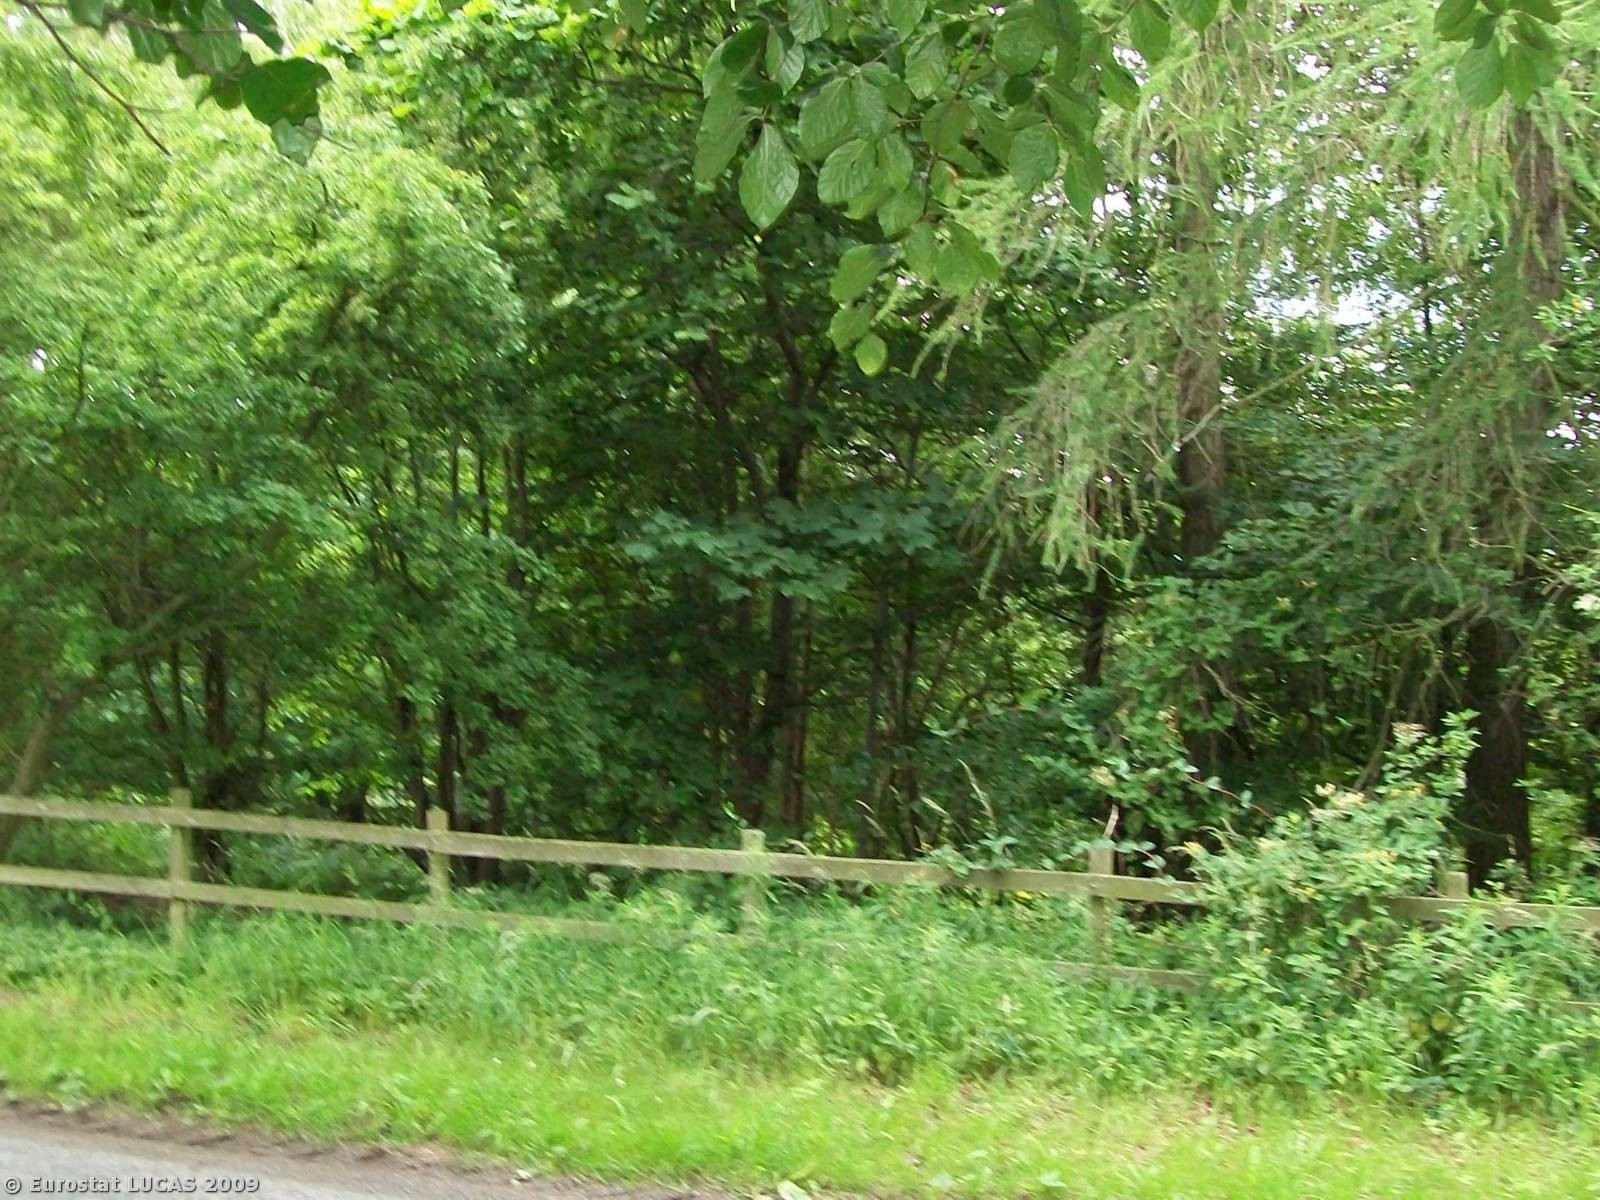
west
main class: Cropland
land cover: Barley
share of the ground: > 75 %
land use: Agriculture (excluding fallow land and kitchen gardens)
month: July
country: GB
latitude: 54.5069
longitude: -1.8684
